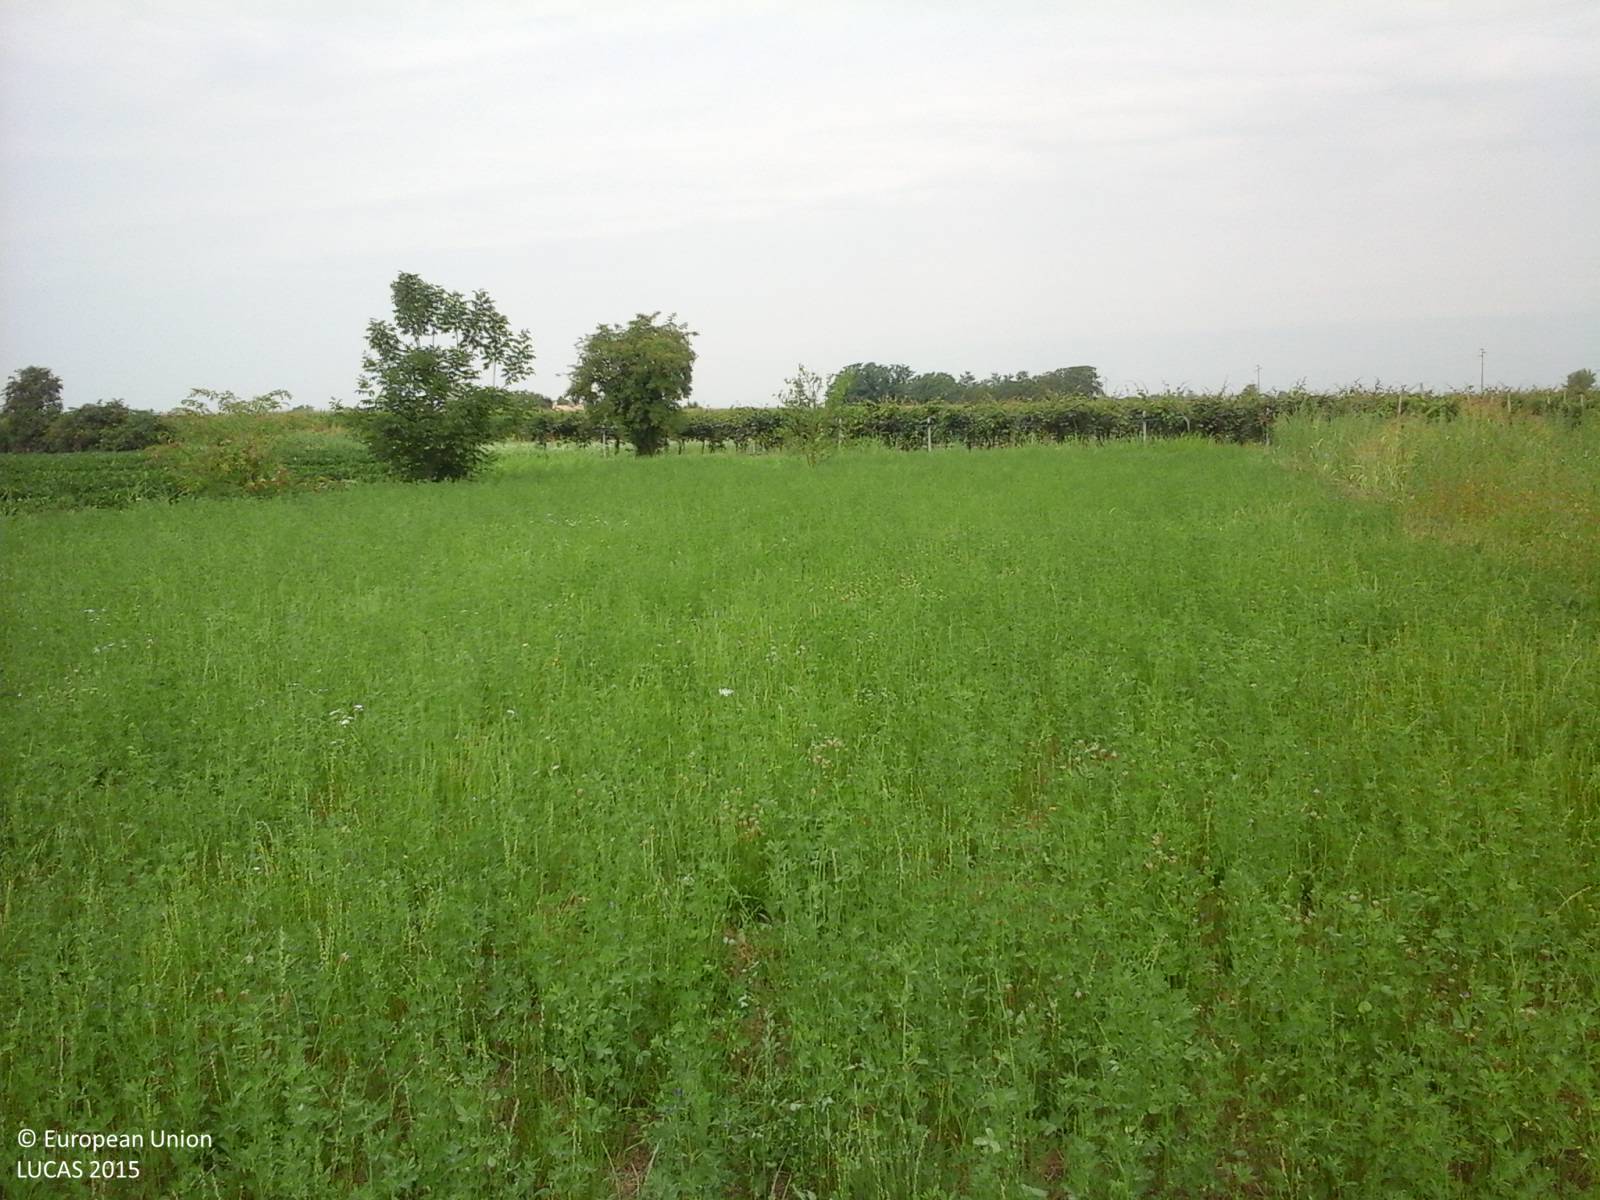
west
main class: Cropland
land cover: Lucerne
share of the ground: > 75 %
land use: Agriculture (excluding fallow land and kitchen gardens)
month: July
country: IT
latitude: 45.9471
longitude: 13.0537
